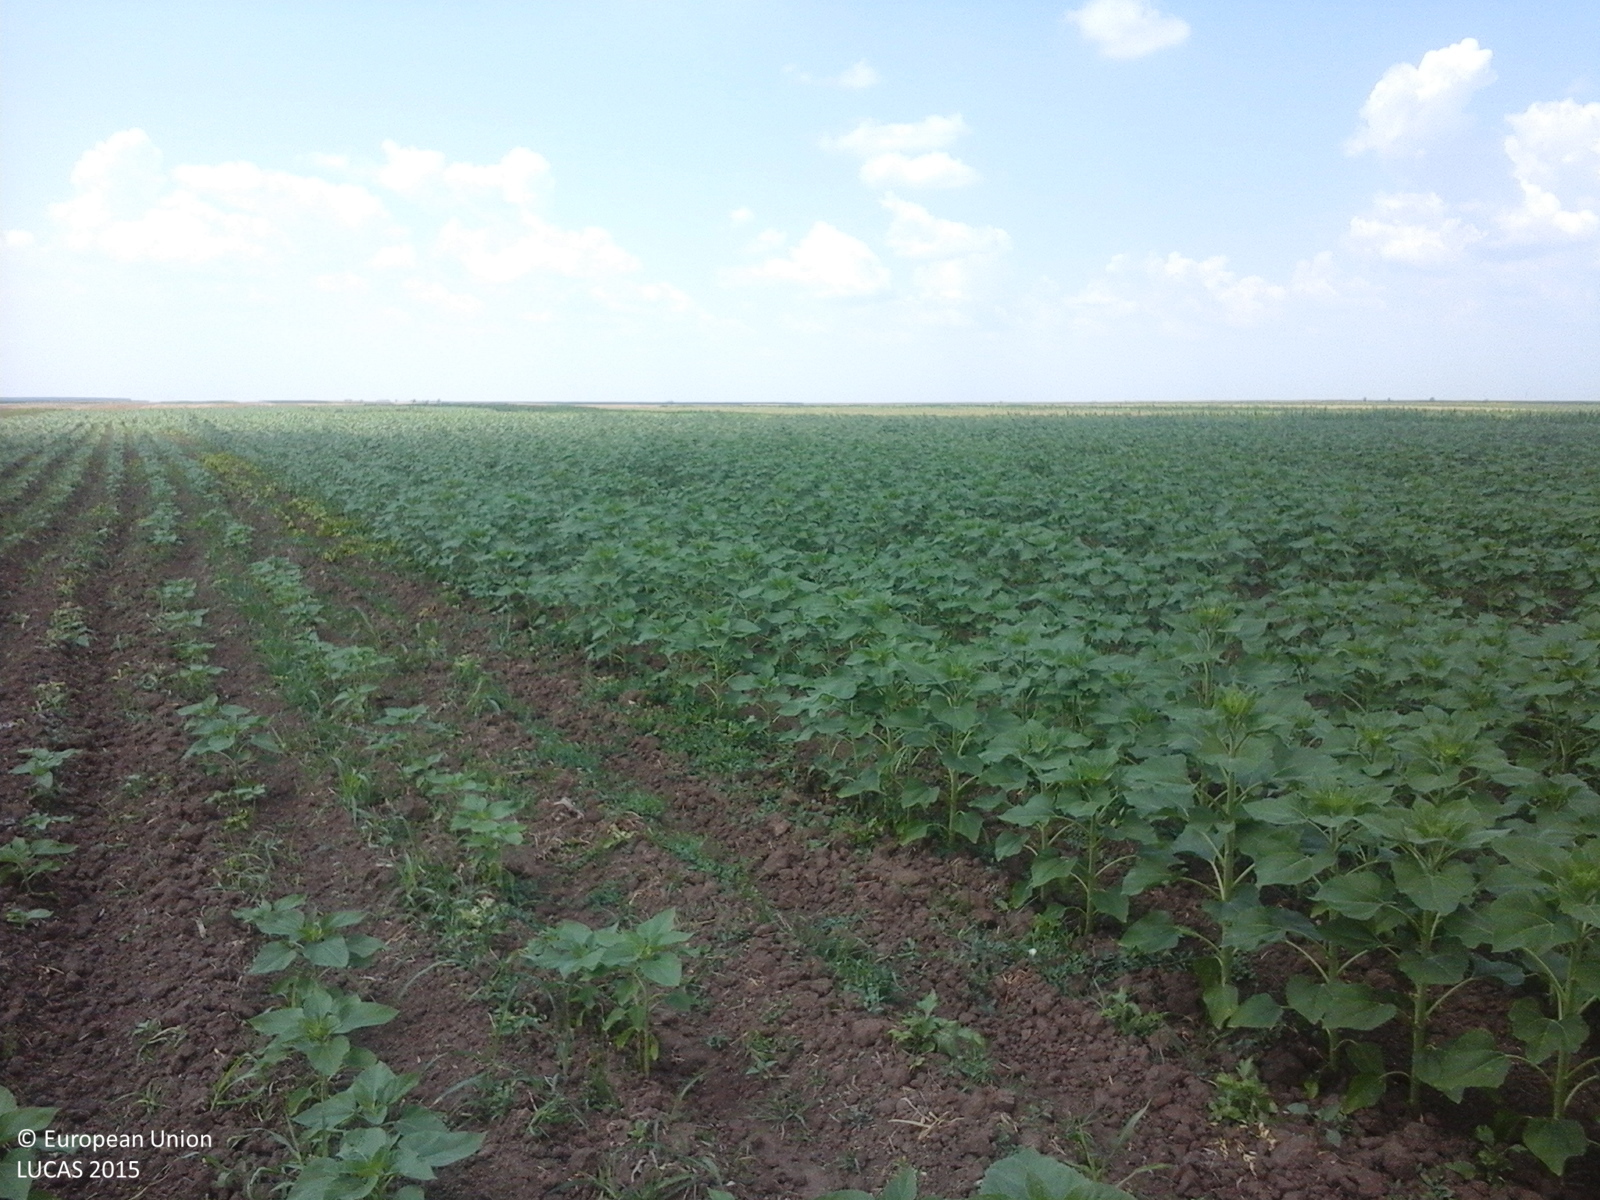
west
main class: Cropland
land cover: Sunflower
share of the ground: 50 - 75 %
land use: Agriculture (excluding fallow land and kitchen gardens)
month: July
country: RO
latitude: 44.1080
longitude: 25.2880
